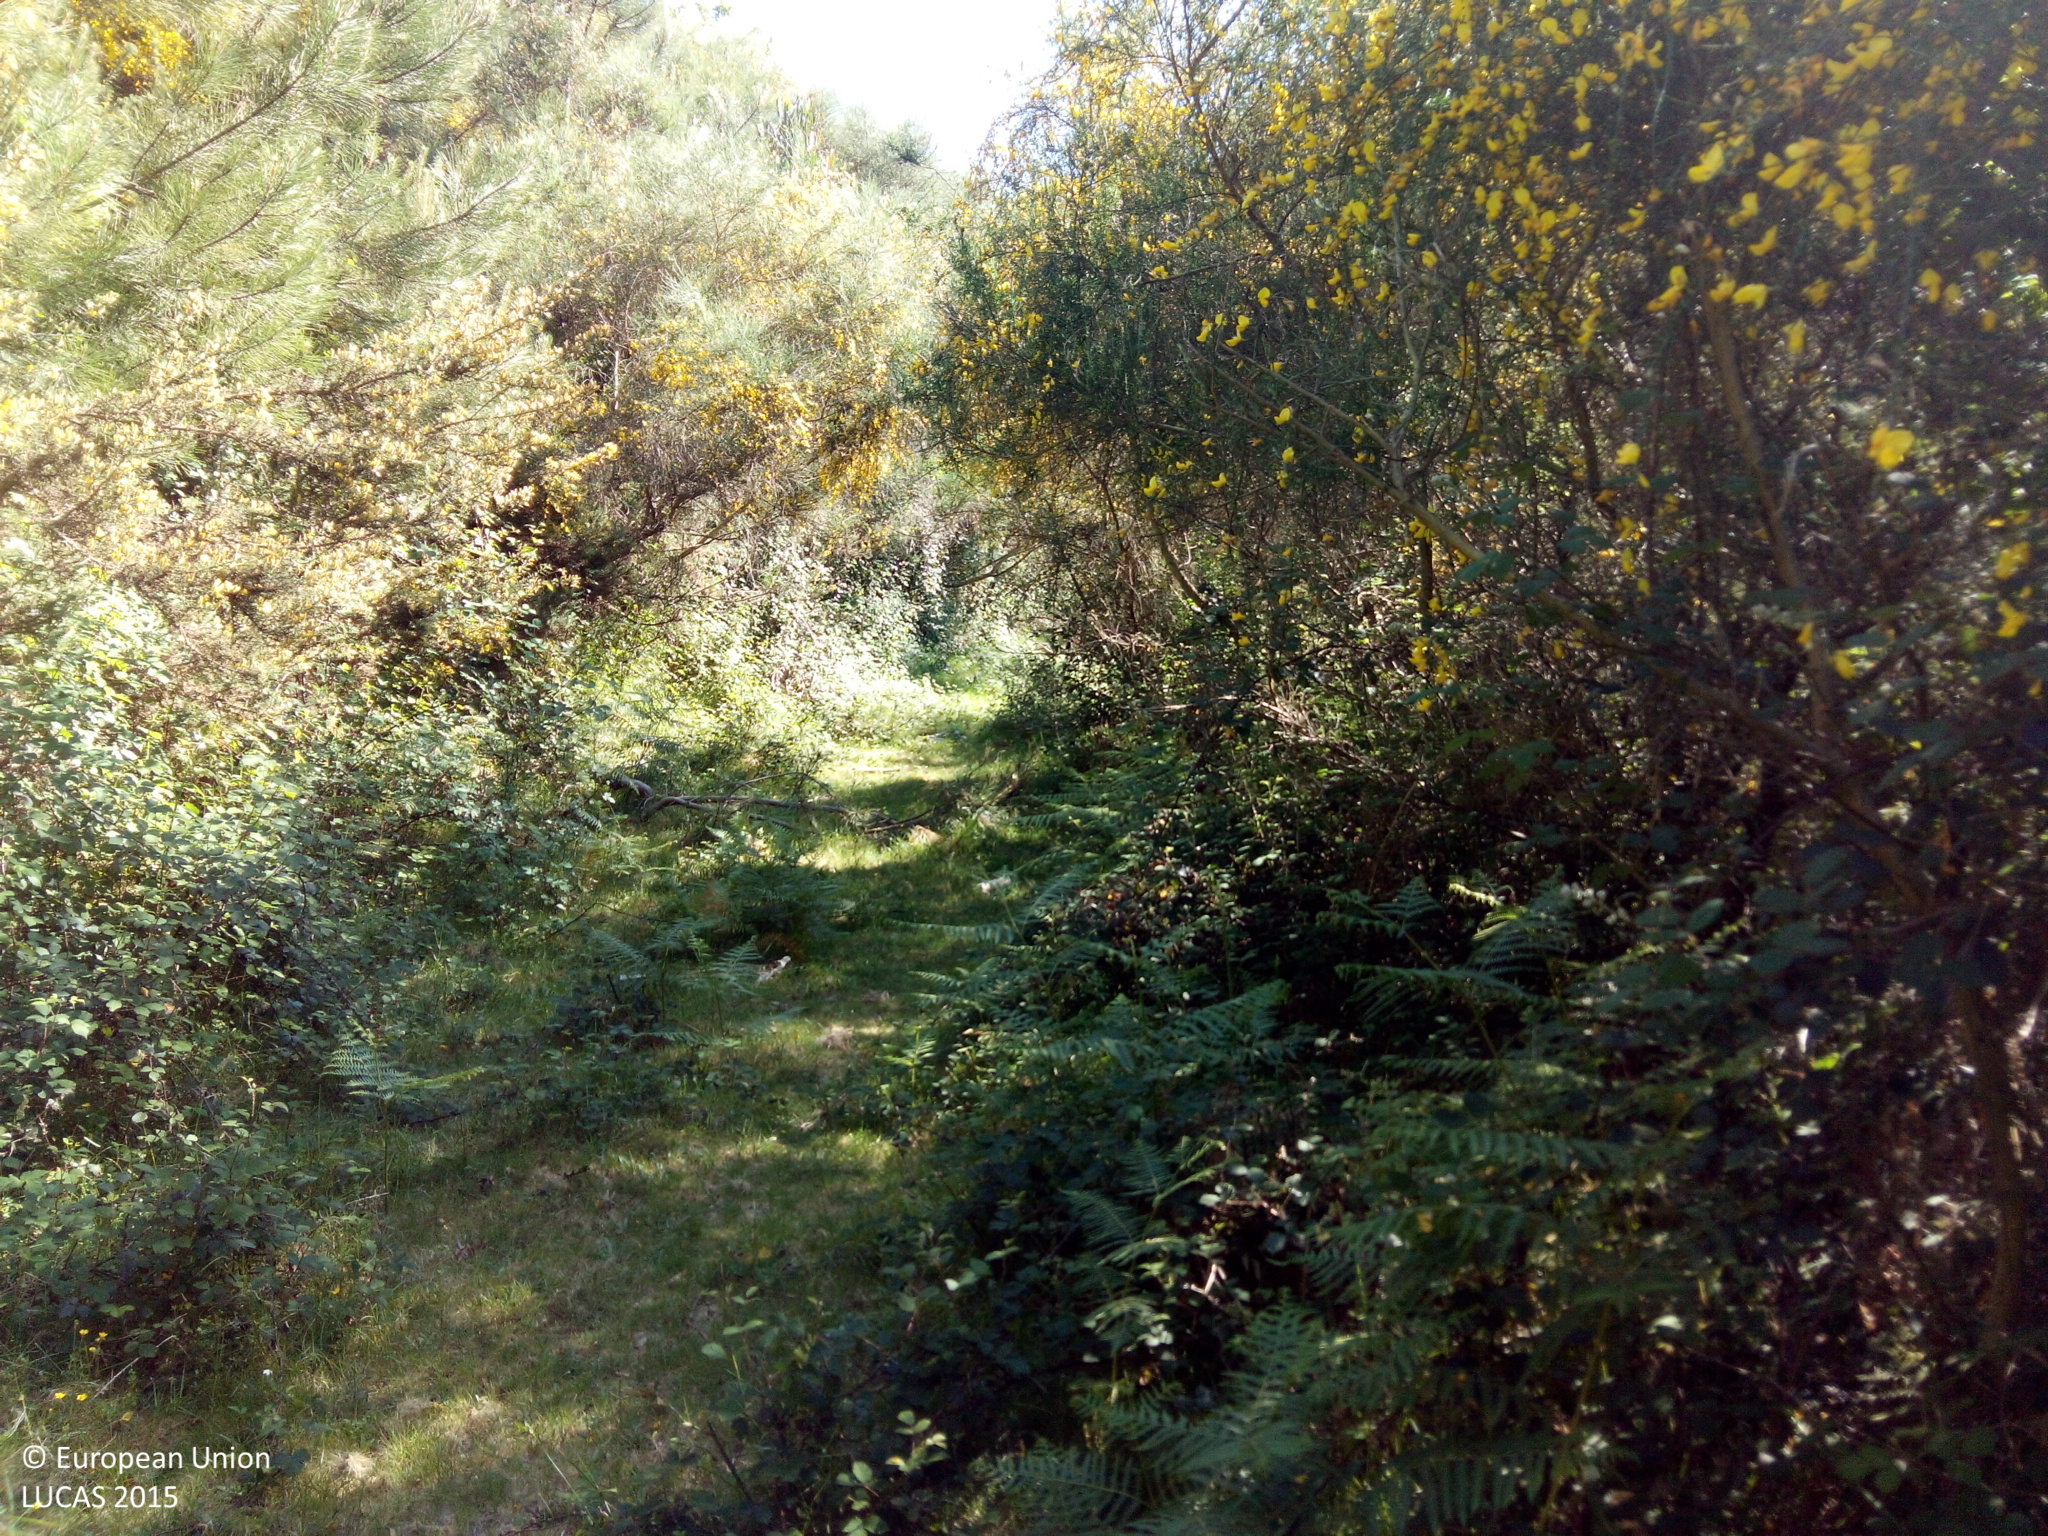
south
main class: Woodland
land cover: Pine dominated coniferous woodland
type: hemiboreal forest and nemoral coniferous forest and mixed broadleaved-coniferous forest
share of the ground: > 75 %
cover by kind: coniferous forest trees 100 %
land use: Forestry
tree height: > 5 m
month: May
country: ES
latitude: 42.0851
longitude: -8.8531
